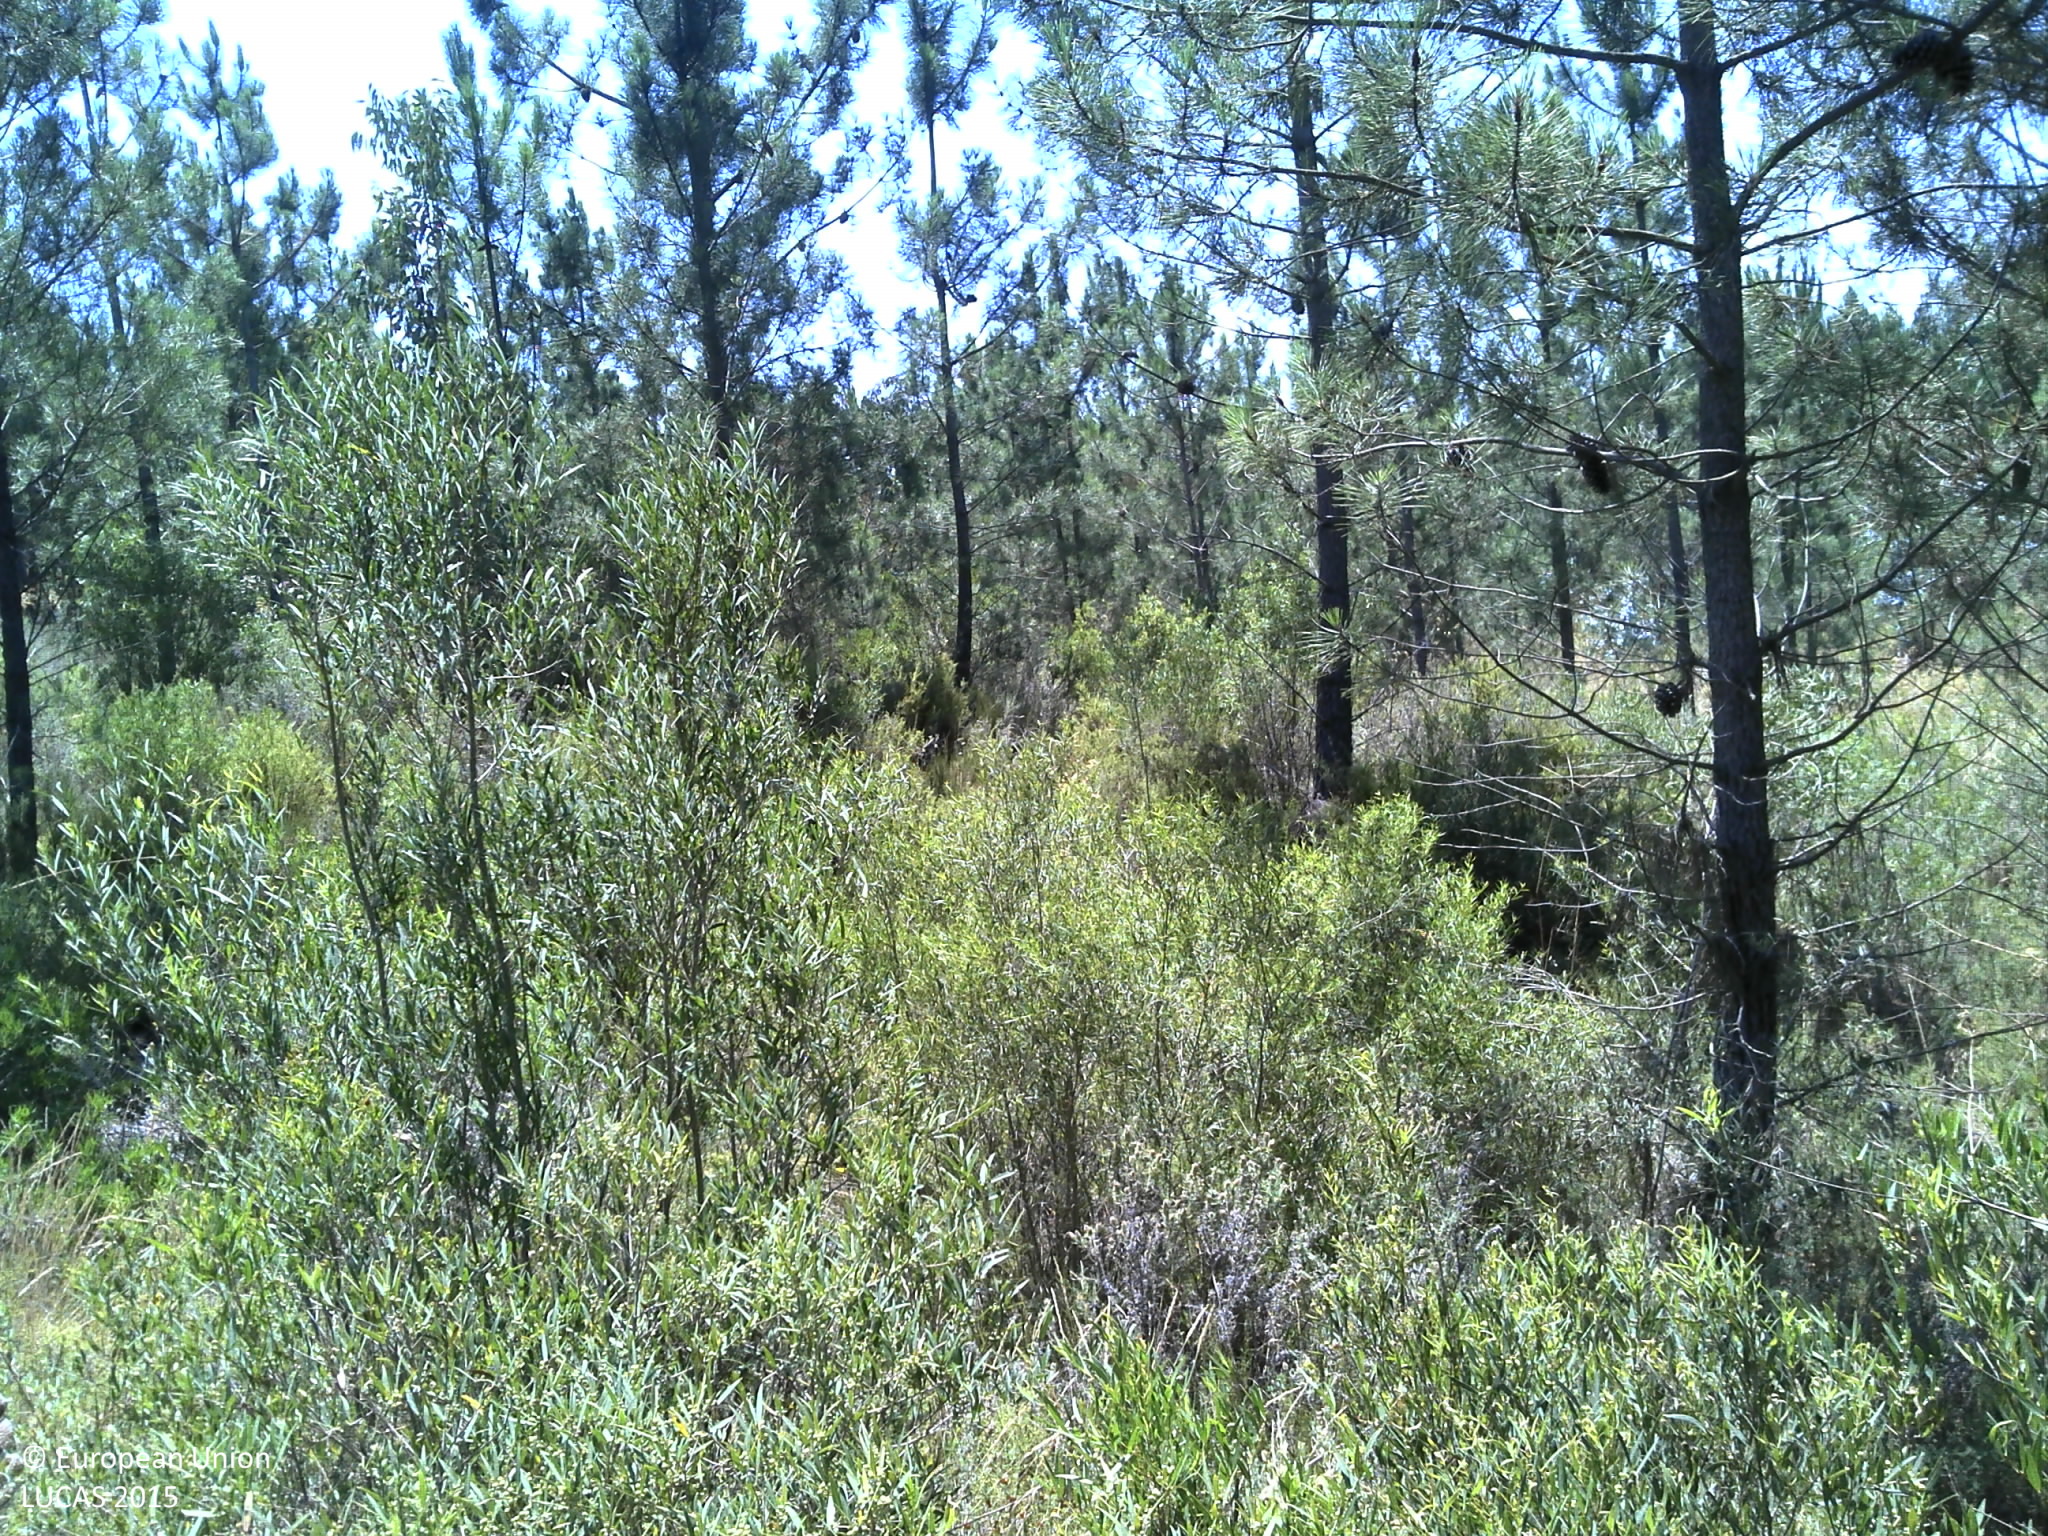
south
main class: Woodland
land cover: Pine dominated coniferous woodland
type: coniferous forest of the mediterranean region
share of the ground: 25 - 50 %
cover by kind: coniferous forest trees 40 %, shrubs 30 %, unconsolidated bare surface 25 %, herbaceous plants 5 %
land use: Forestry
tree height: > 5 m
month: June
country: PT
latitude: 38.6027
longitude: -9.1457
